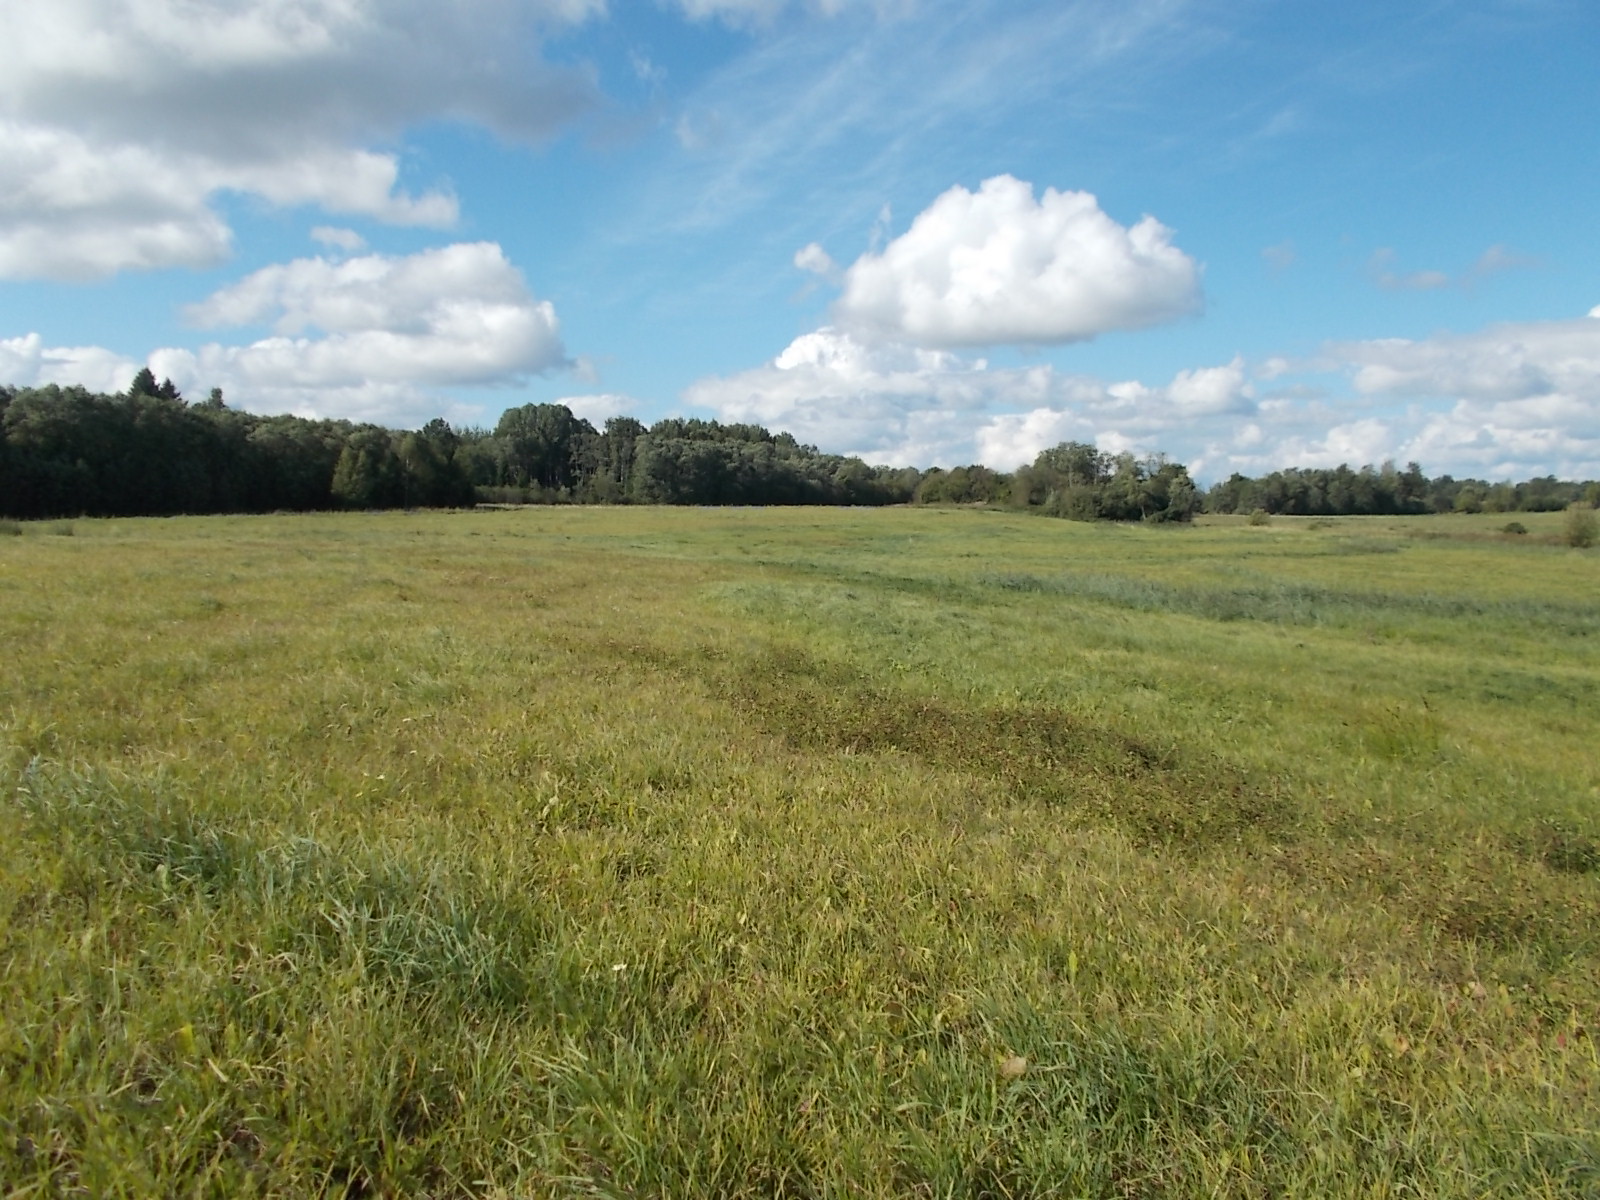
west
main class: Grassland
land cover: Grassland without tree/shrub cover
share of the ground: > 75 %
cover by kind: herbaceous plants 100 %
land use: Agriculture (excluding fallow land and kitchen gardens)
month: September
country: LV
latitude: 56.9906
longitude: 22.9163
